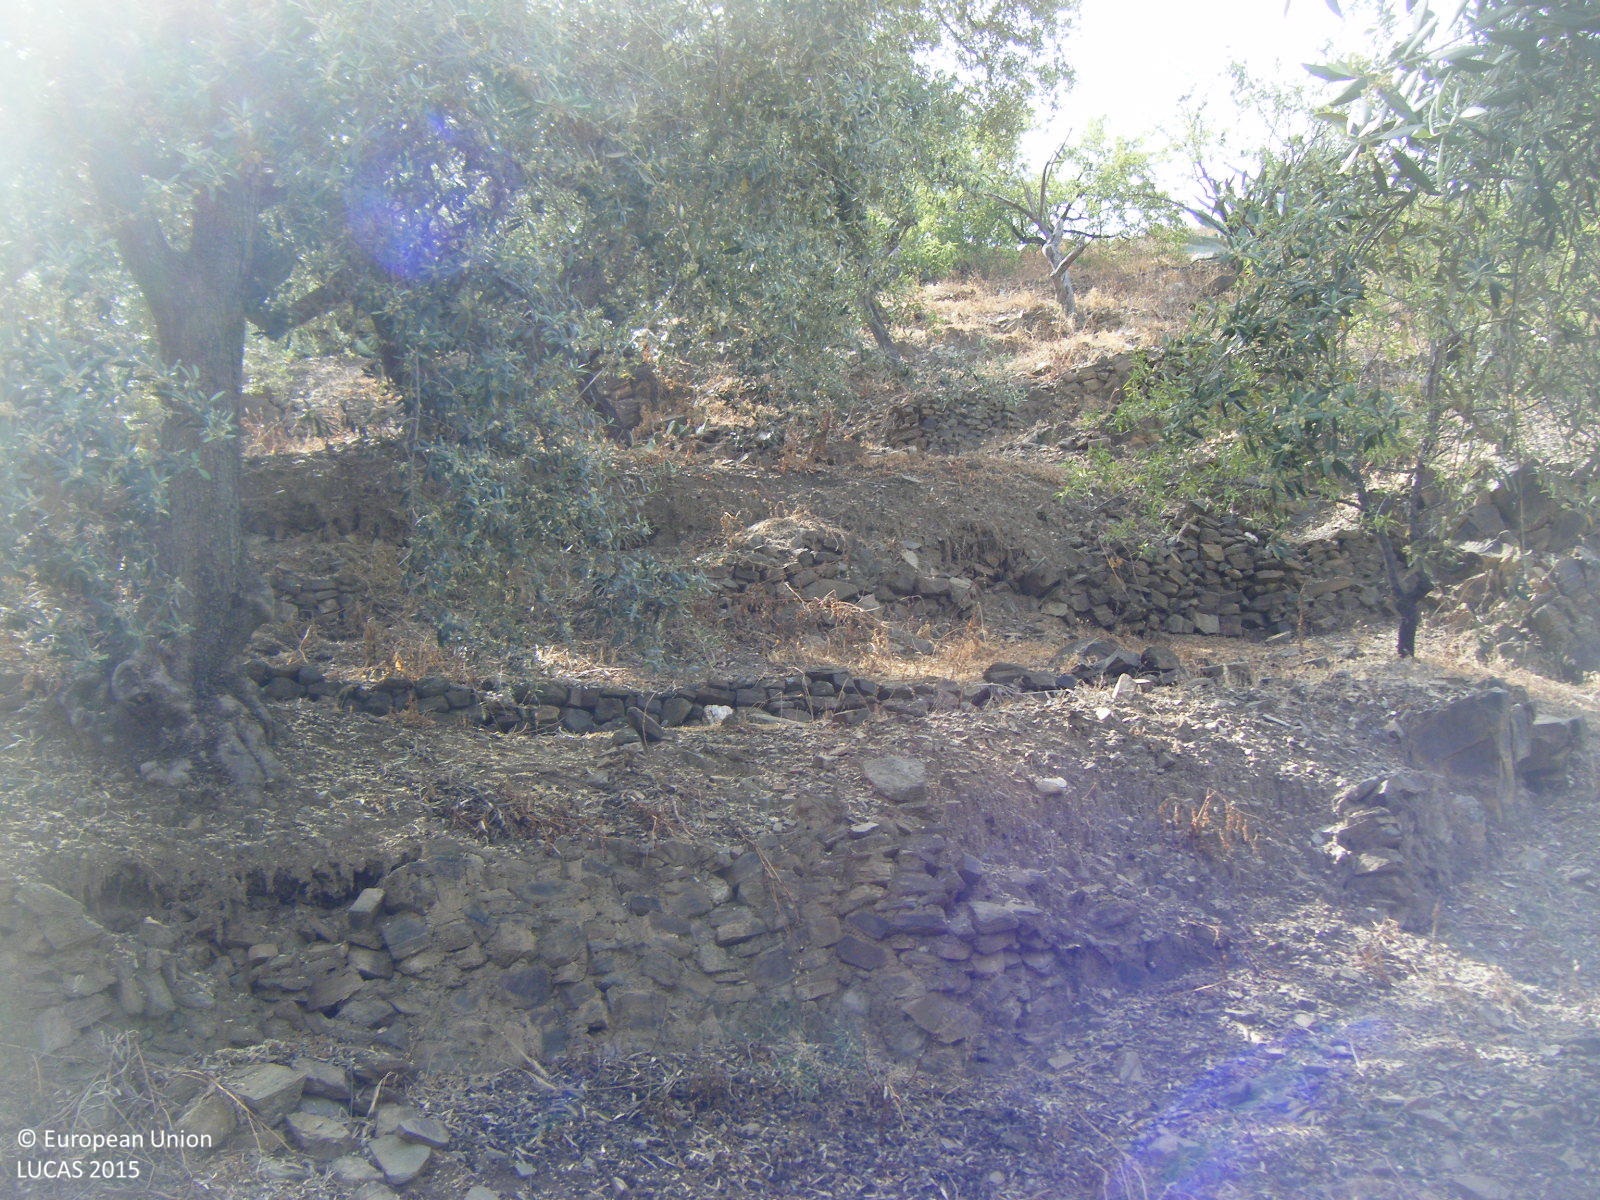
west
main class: Cropland
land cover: Olive groves
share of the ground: 25 - 50 %
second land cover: Other bare soil
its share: > 75 %
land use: Agriculture (excluding fallow land and kitchen gardens)
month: May
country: ES
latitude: 36.8150
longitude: -4.0108
